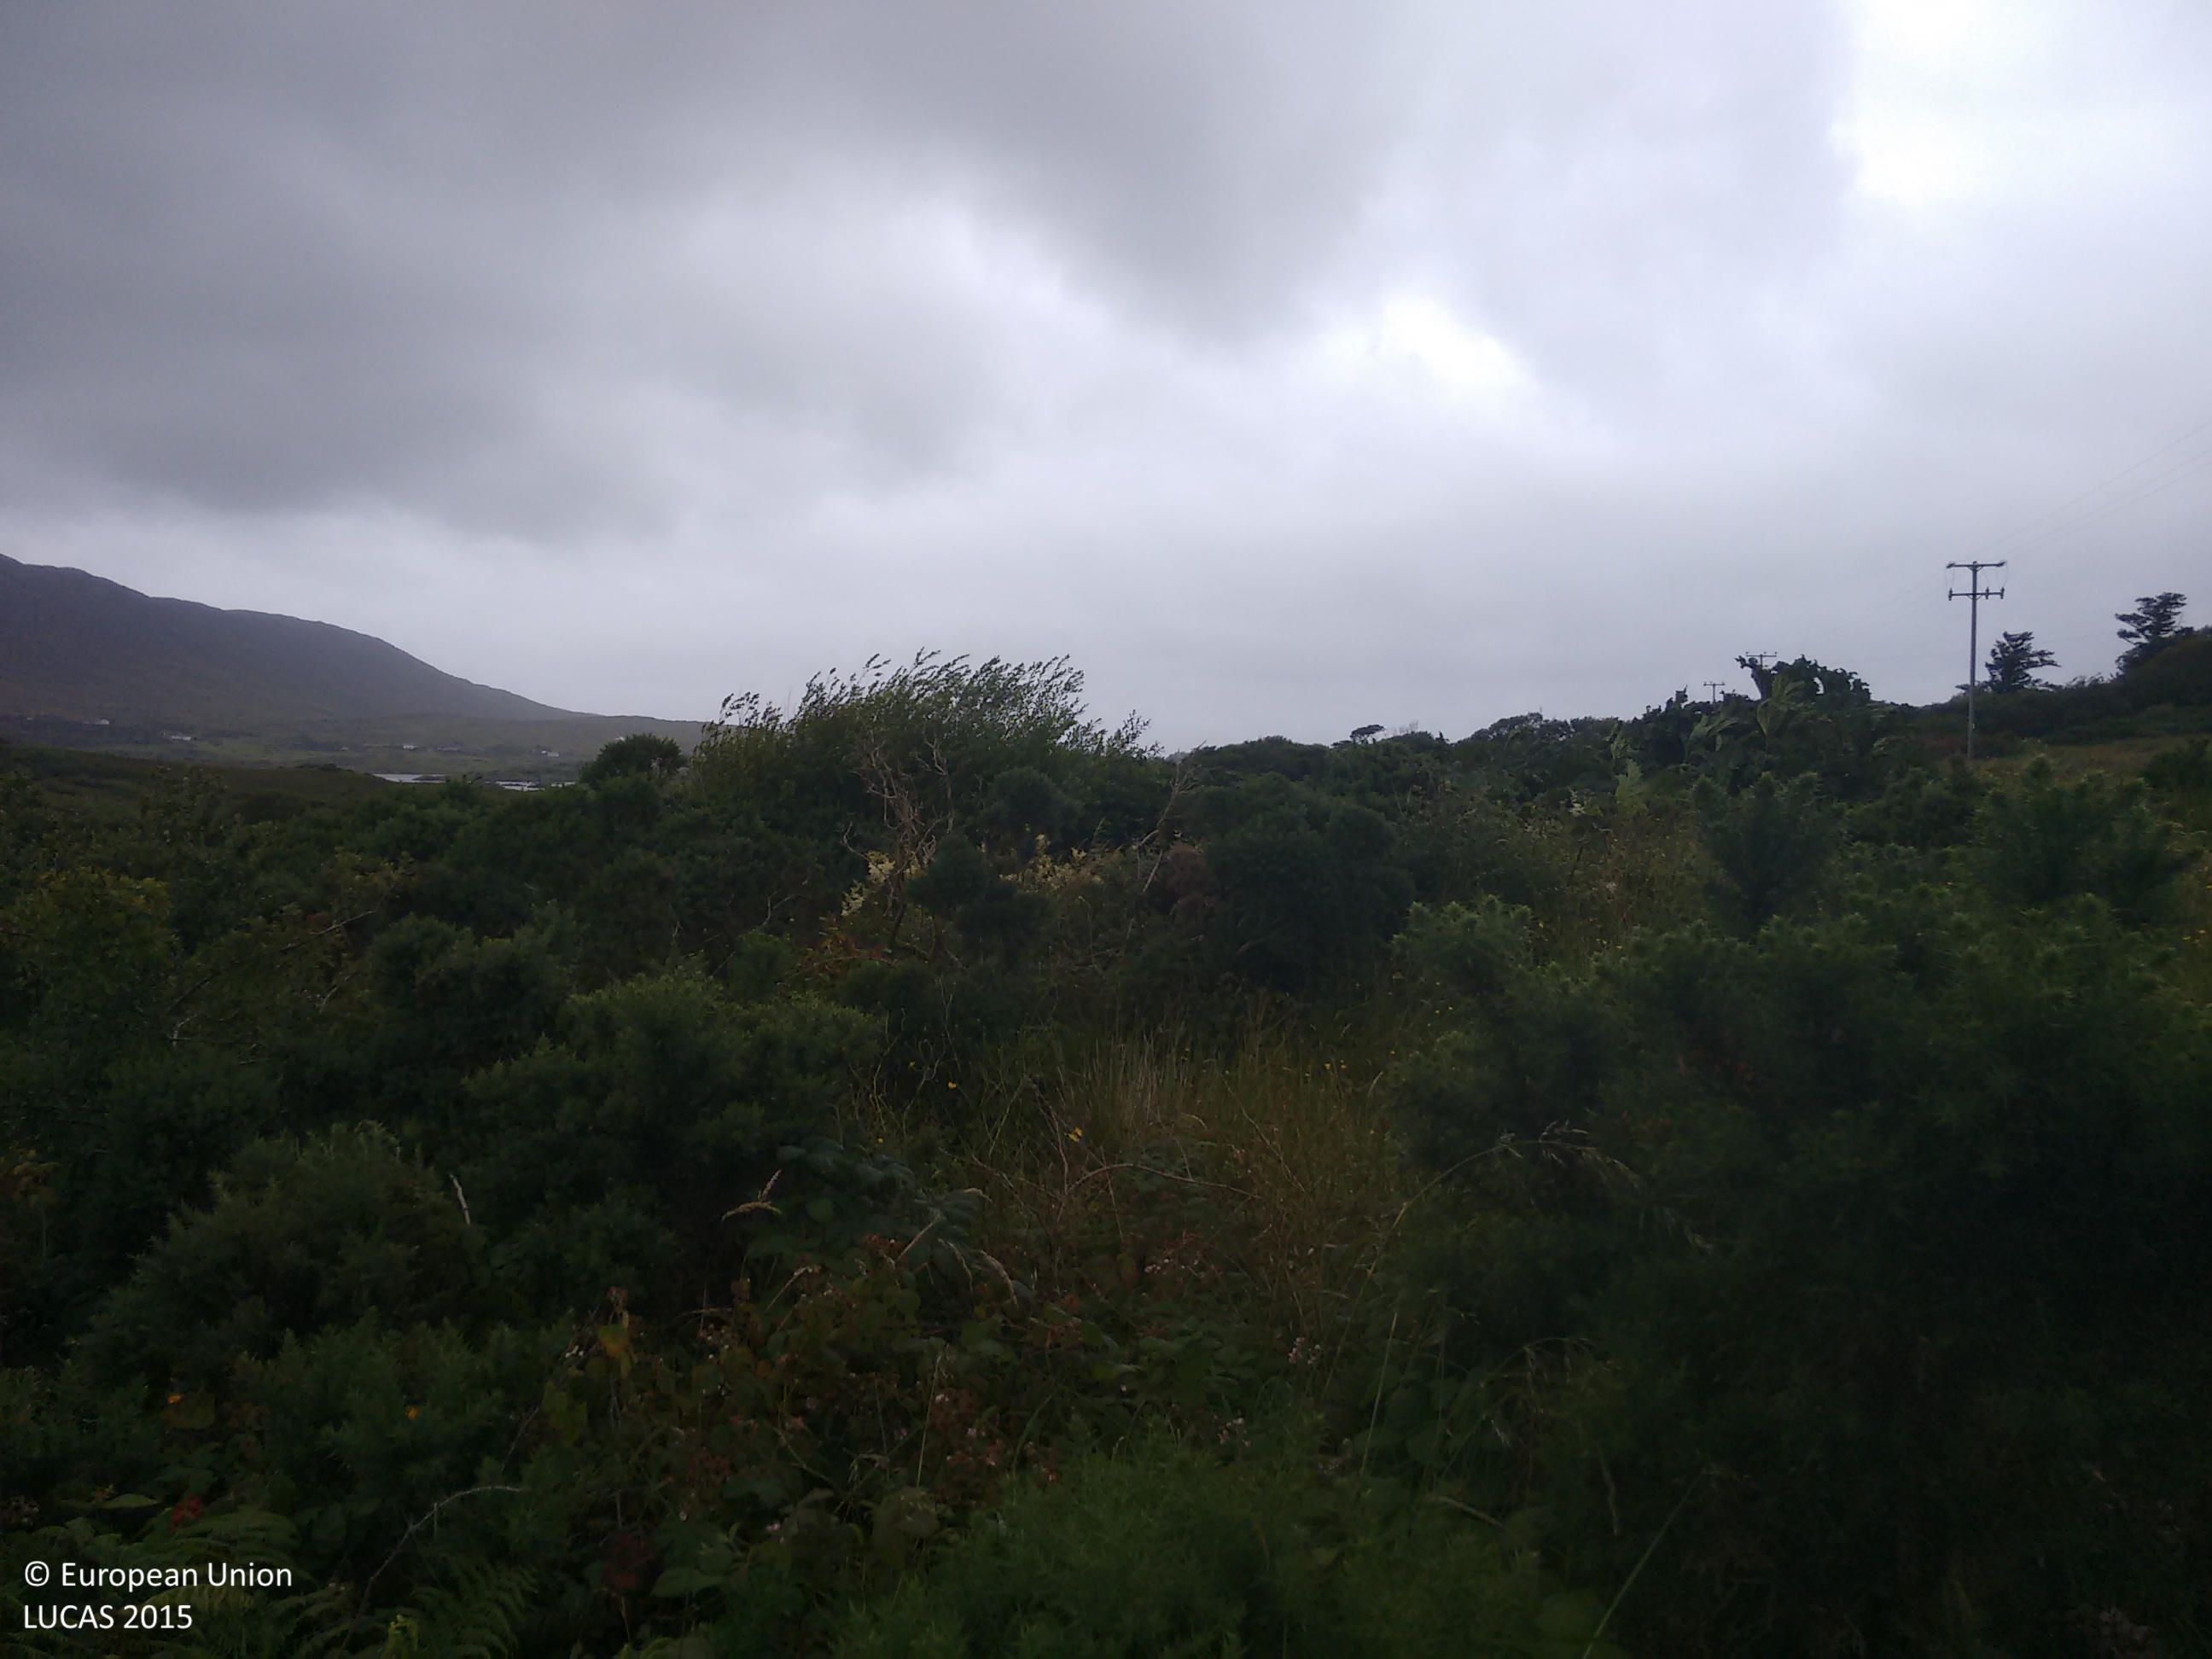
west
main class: Shrubland
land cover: Shrubland without tree cover
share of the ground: > 75 %
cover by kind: shrubs 60 %, herbaceous plants 40 %
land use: Agriculture (excluding fallow land and kitchen gardens)
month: August
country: IE
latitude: 53.5882
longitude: -9.9667
